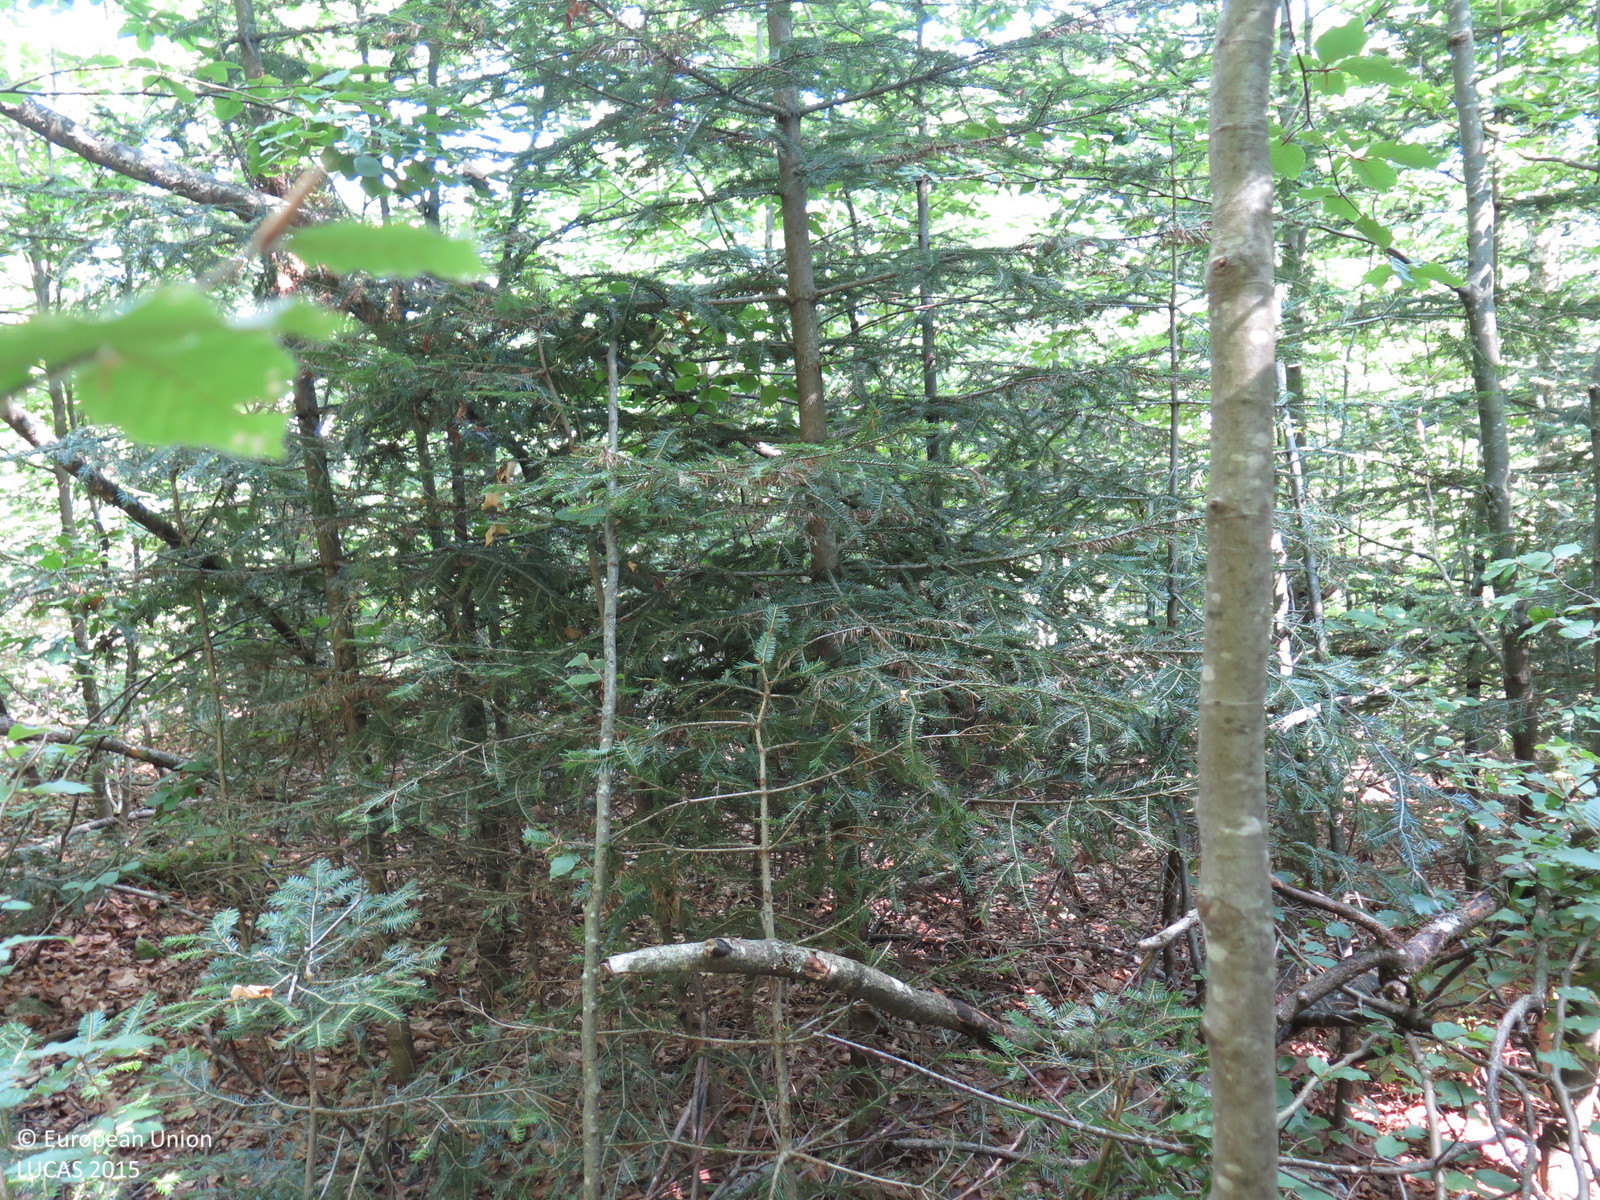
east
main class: Woodland
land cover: Broadleaved woodland
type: mountainous beech forest
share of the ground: > 75 %
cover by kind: broadleaved forest trees 90 %, herbaceous plants 5 %, unconsolidated bare surface 5 %
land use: Forestry
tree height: > 5 m
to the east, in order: Broadleaved woodland; Tracks; Broadleaved woodland
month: September
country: HR
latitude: 45.5252
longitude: 14.7200
